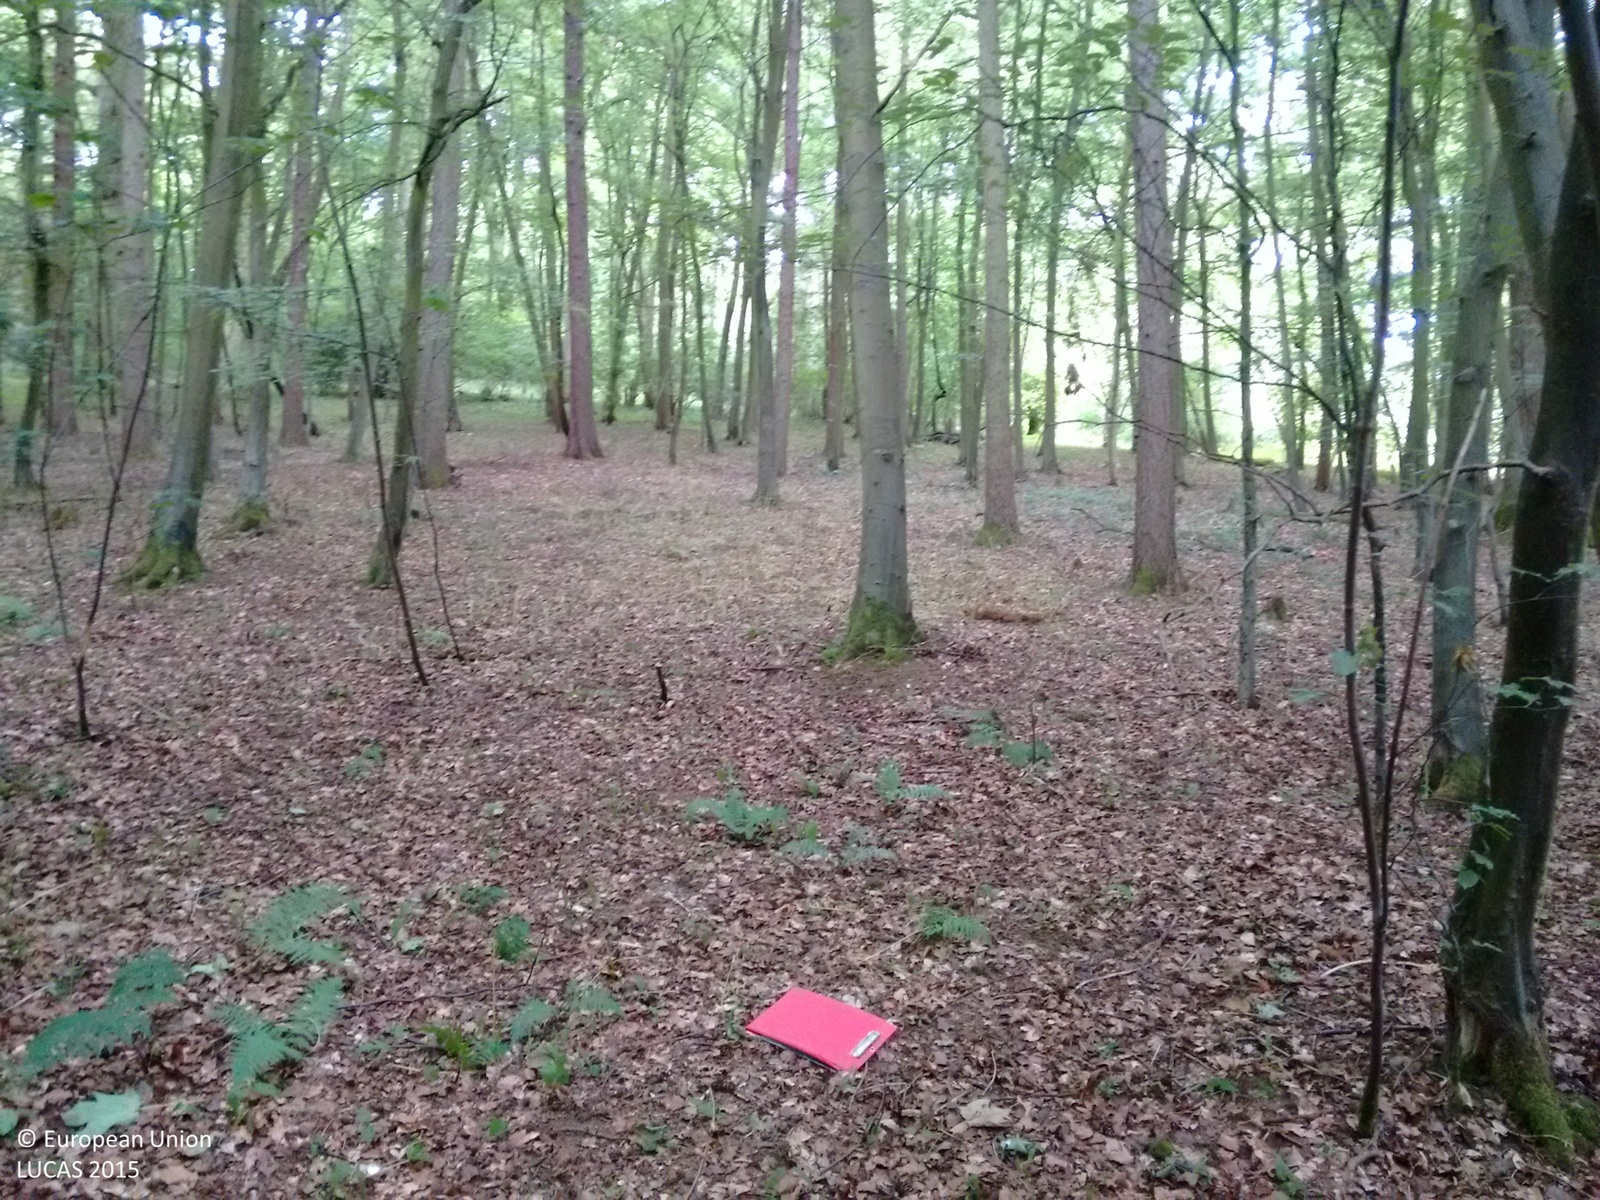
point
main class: Woodland
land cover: Broadleaved woodland
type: mesophytic deciduous forest
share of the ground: > 75 %
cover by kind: broadleaved forest trees 95 %, herbaceous plants 5 %
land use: Amenities, museums, leisure
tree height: > 5 m
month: July
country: GB
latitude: 51.2515
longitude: -0.3670
